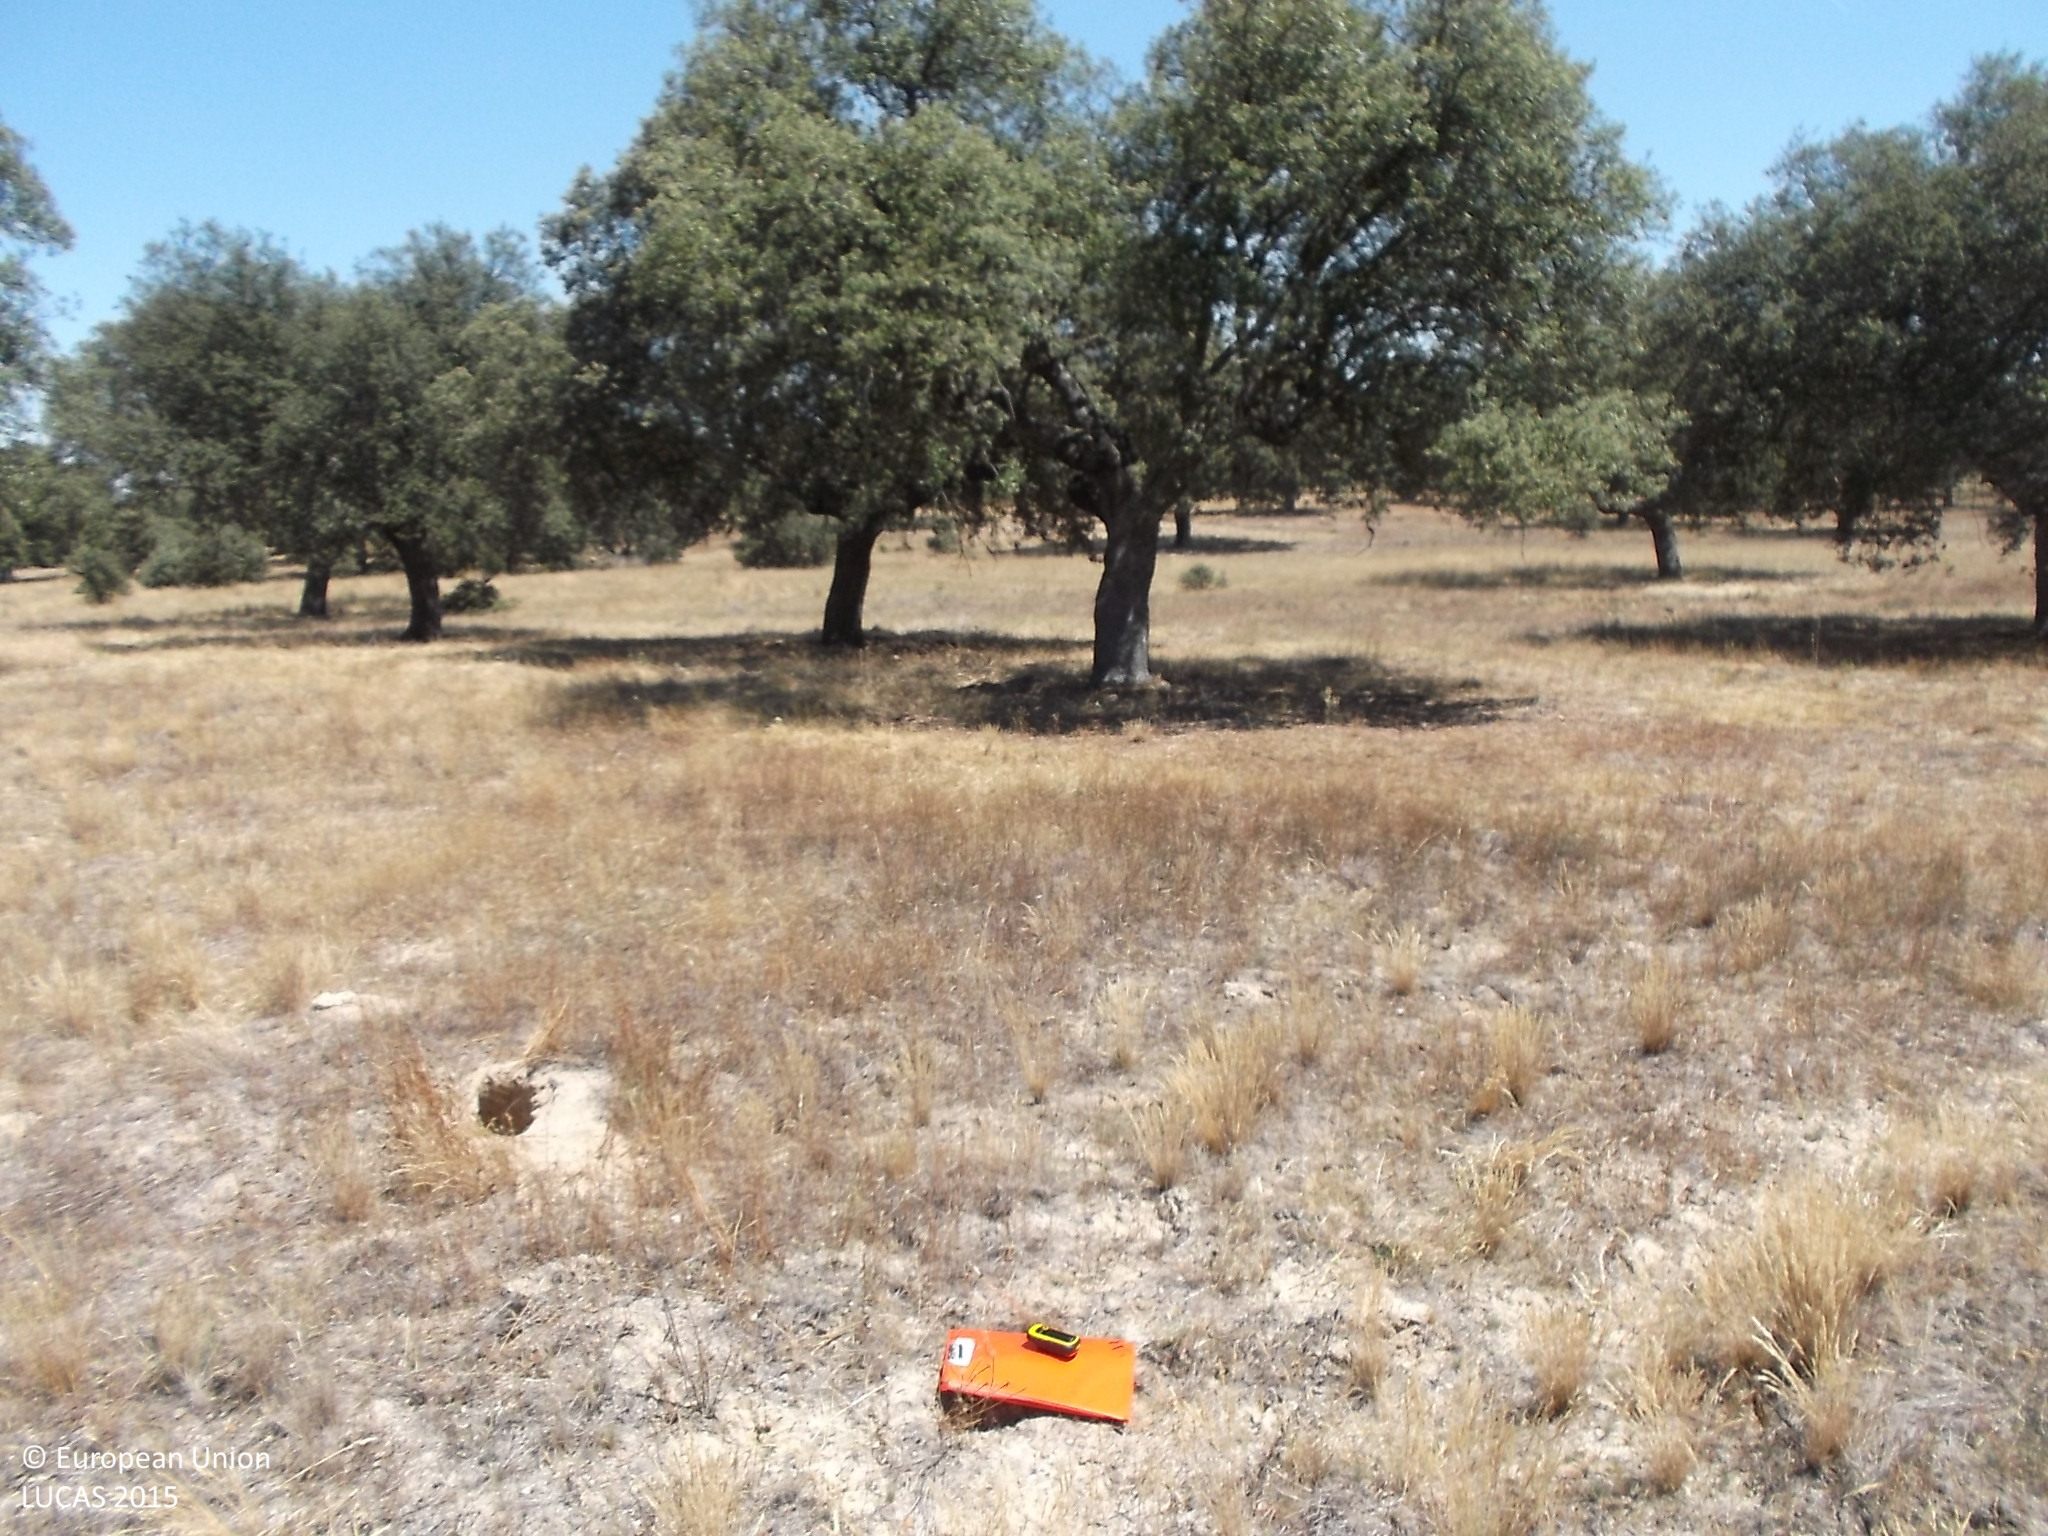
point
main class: Woodland
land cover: Broadleaved woodland
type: broadleaved evergreen forest
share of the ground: 50 - 75 %
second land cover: Grassland without tree/shrub cover
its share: 50 - 75 %
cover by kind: broadleaved forest trees 50 %, herbaceous plants 50 %
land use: Forestry
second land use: Agriculture (excluding fallow land and kitchen gardens)
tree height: < 5 m
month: July
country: ES
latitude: 41.3670
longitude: -5.8067
